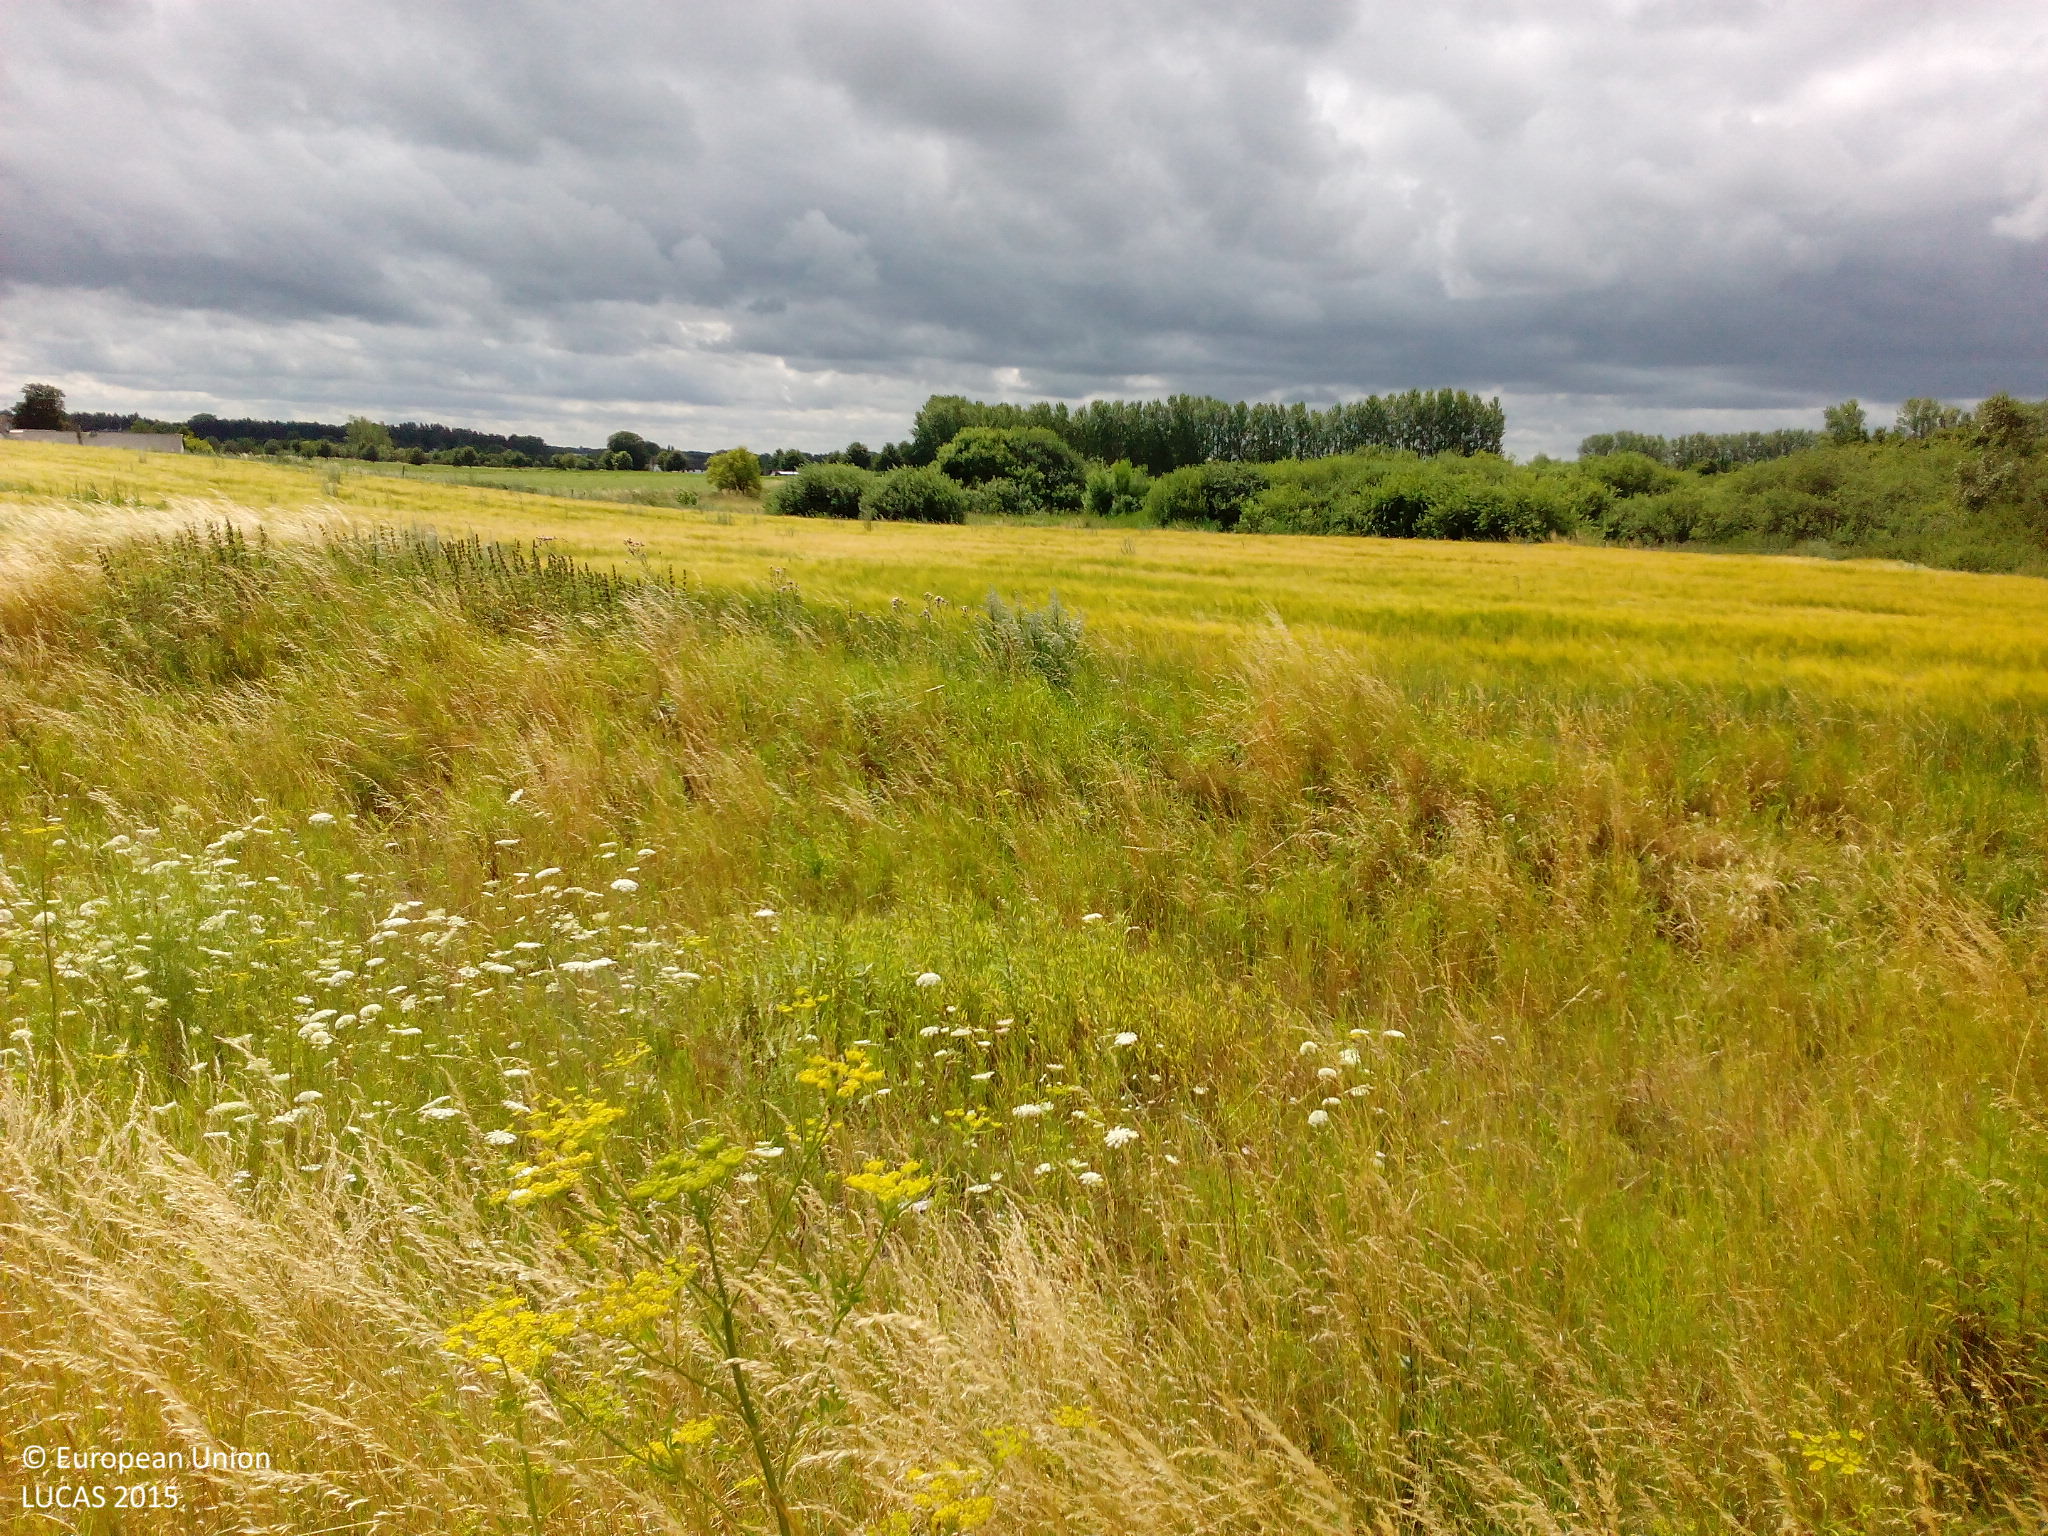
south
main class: Woodland
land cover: Broadleaved woodland
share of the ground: > 75 %
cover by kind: broadleaved forest trees 80 %, herbaceous plants 20 %
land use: Semi-natural and natural areas not in use
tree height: > 5 m
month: July
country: DK
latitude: 55.9527
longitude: 12.2240
